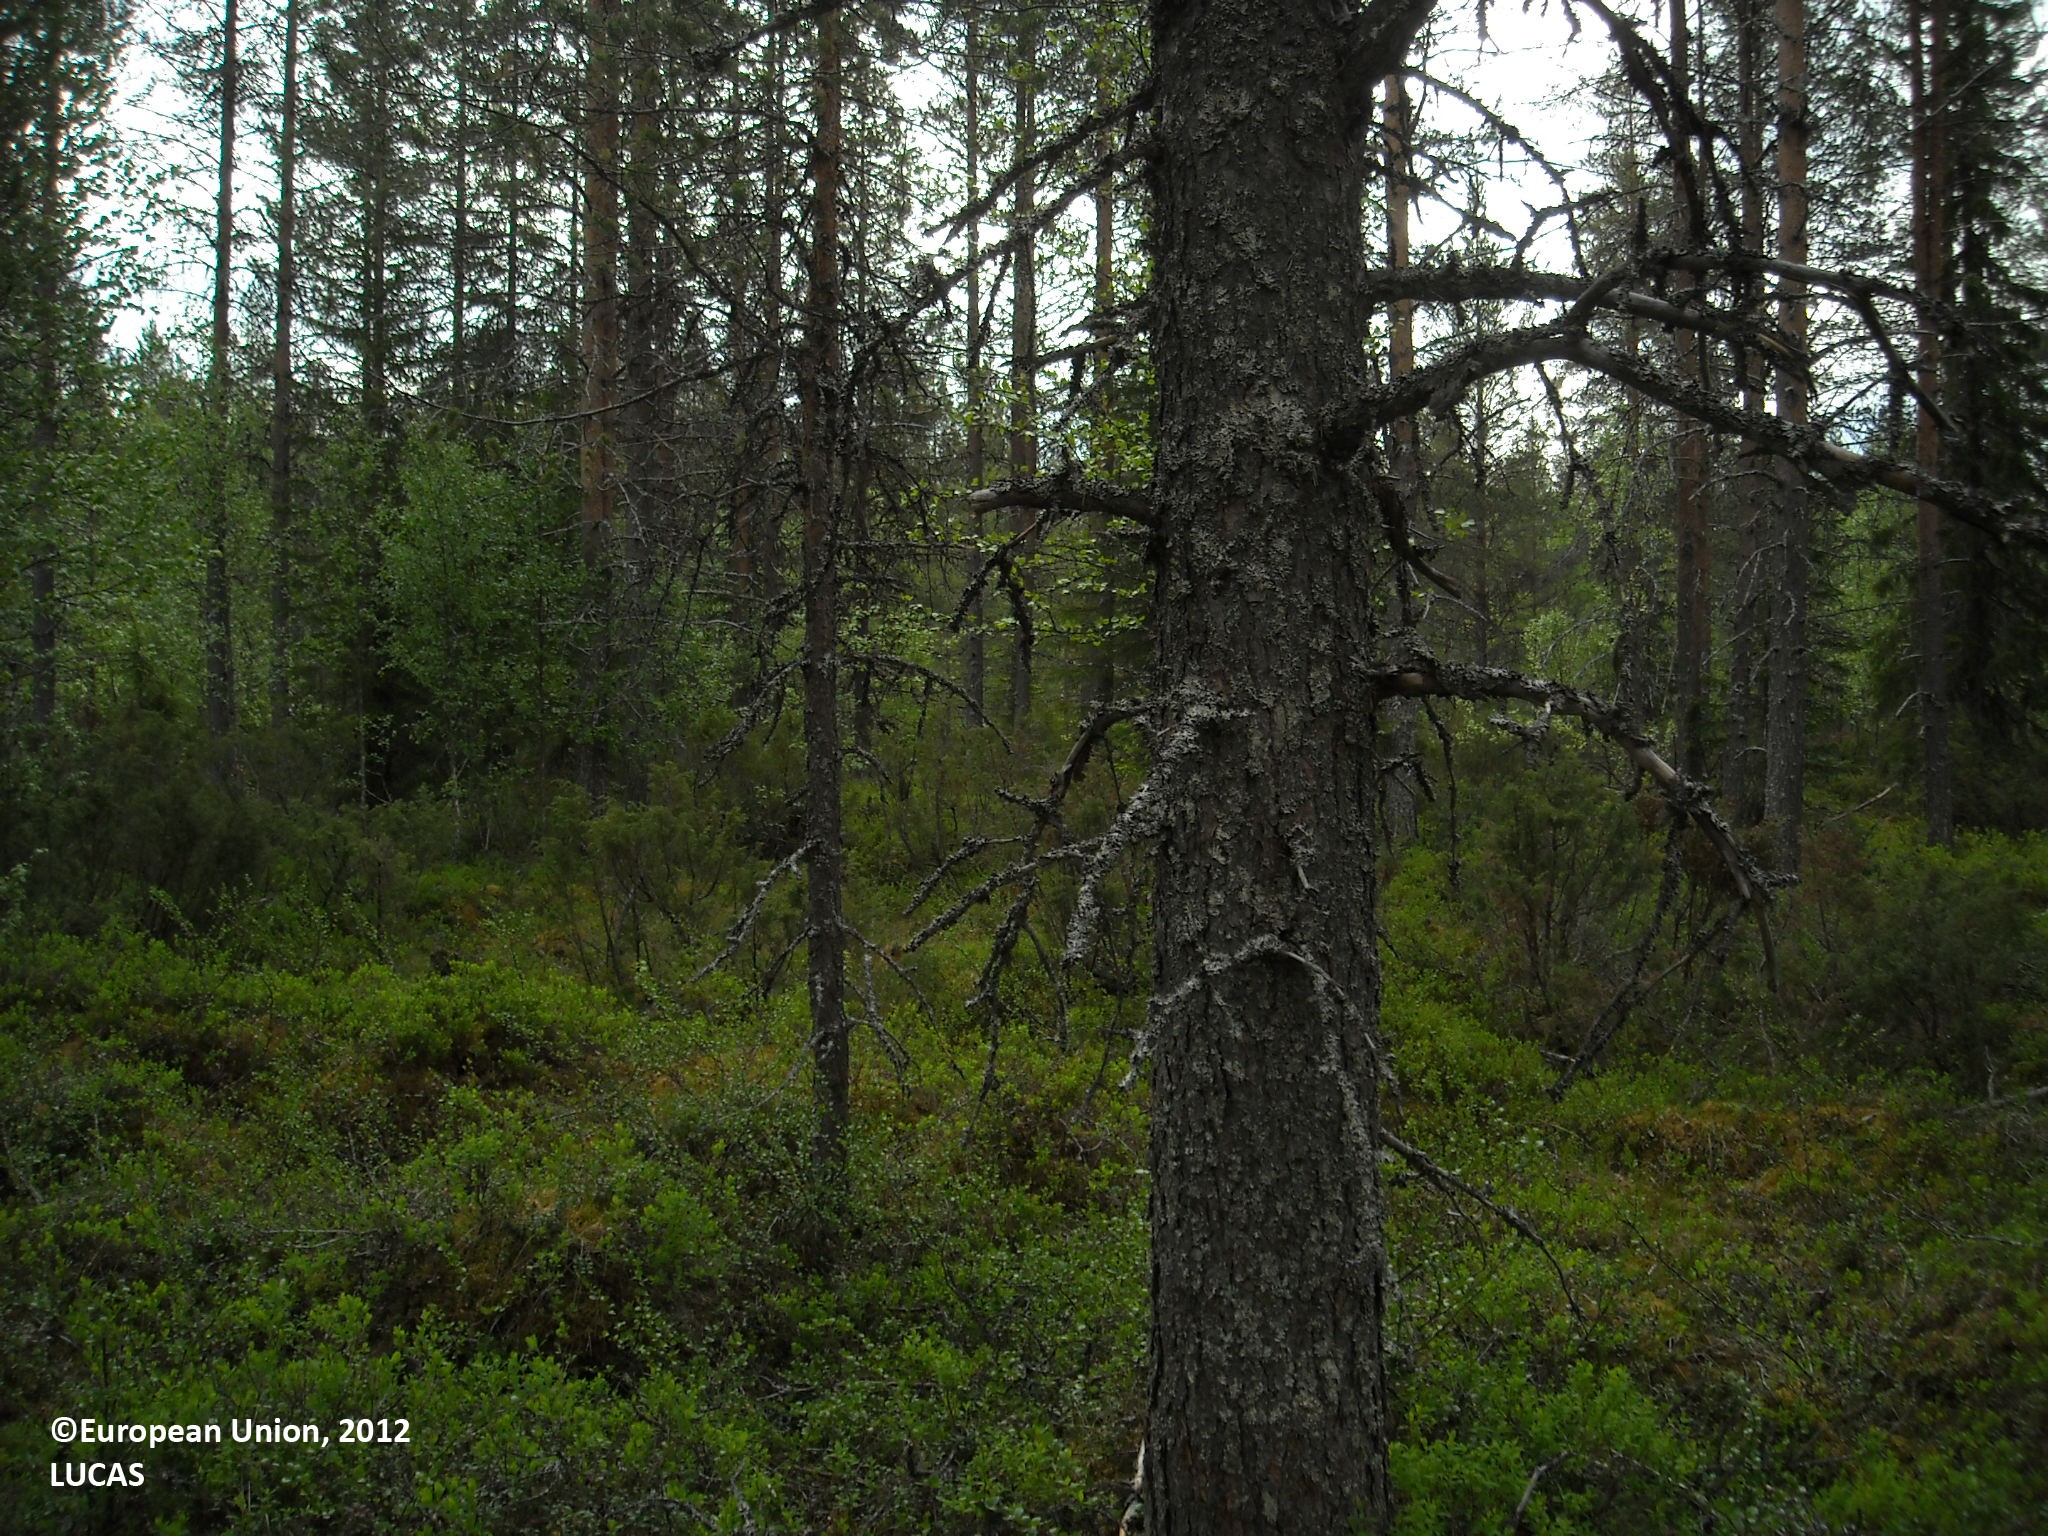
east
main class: Woodland
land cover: Pine dominated coniferous woodland
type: boreal forest
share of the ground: 50 - 75 %
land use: Forestry
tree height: > 5 m
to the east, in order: Pine dominated coniferous woodland; Pine dominated mixed woodland; Pine dominated coniferous woodland
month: June
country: FI
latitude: 65.5897
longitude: 28.0353
